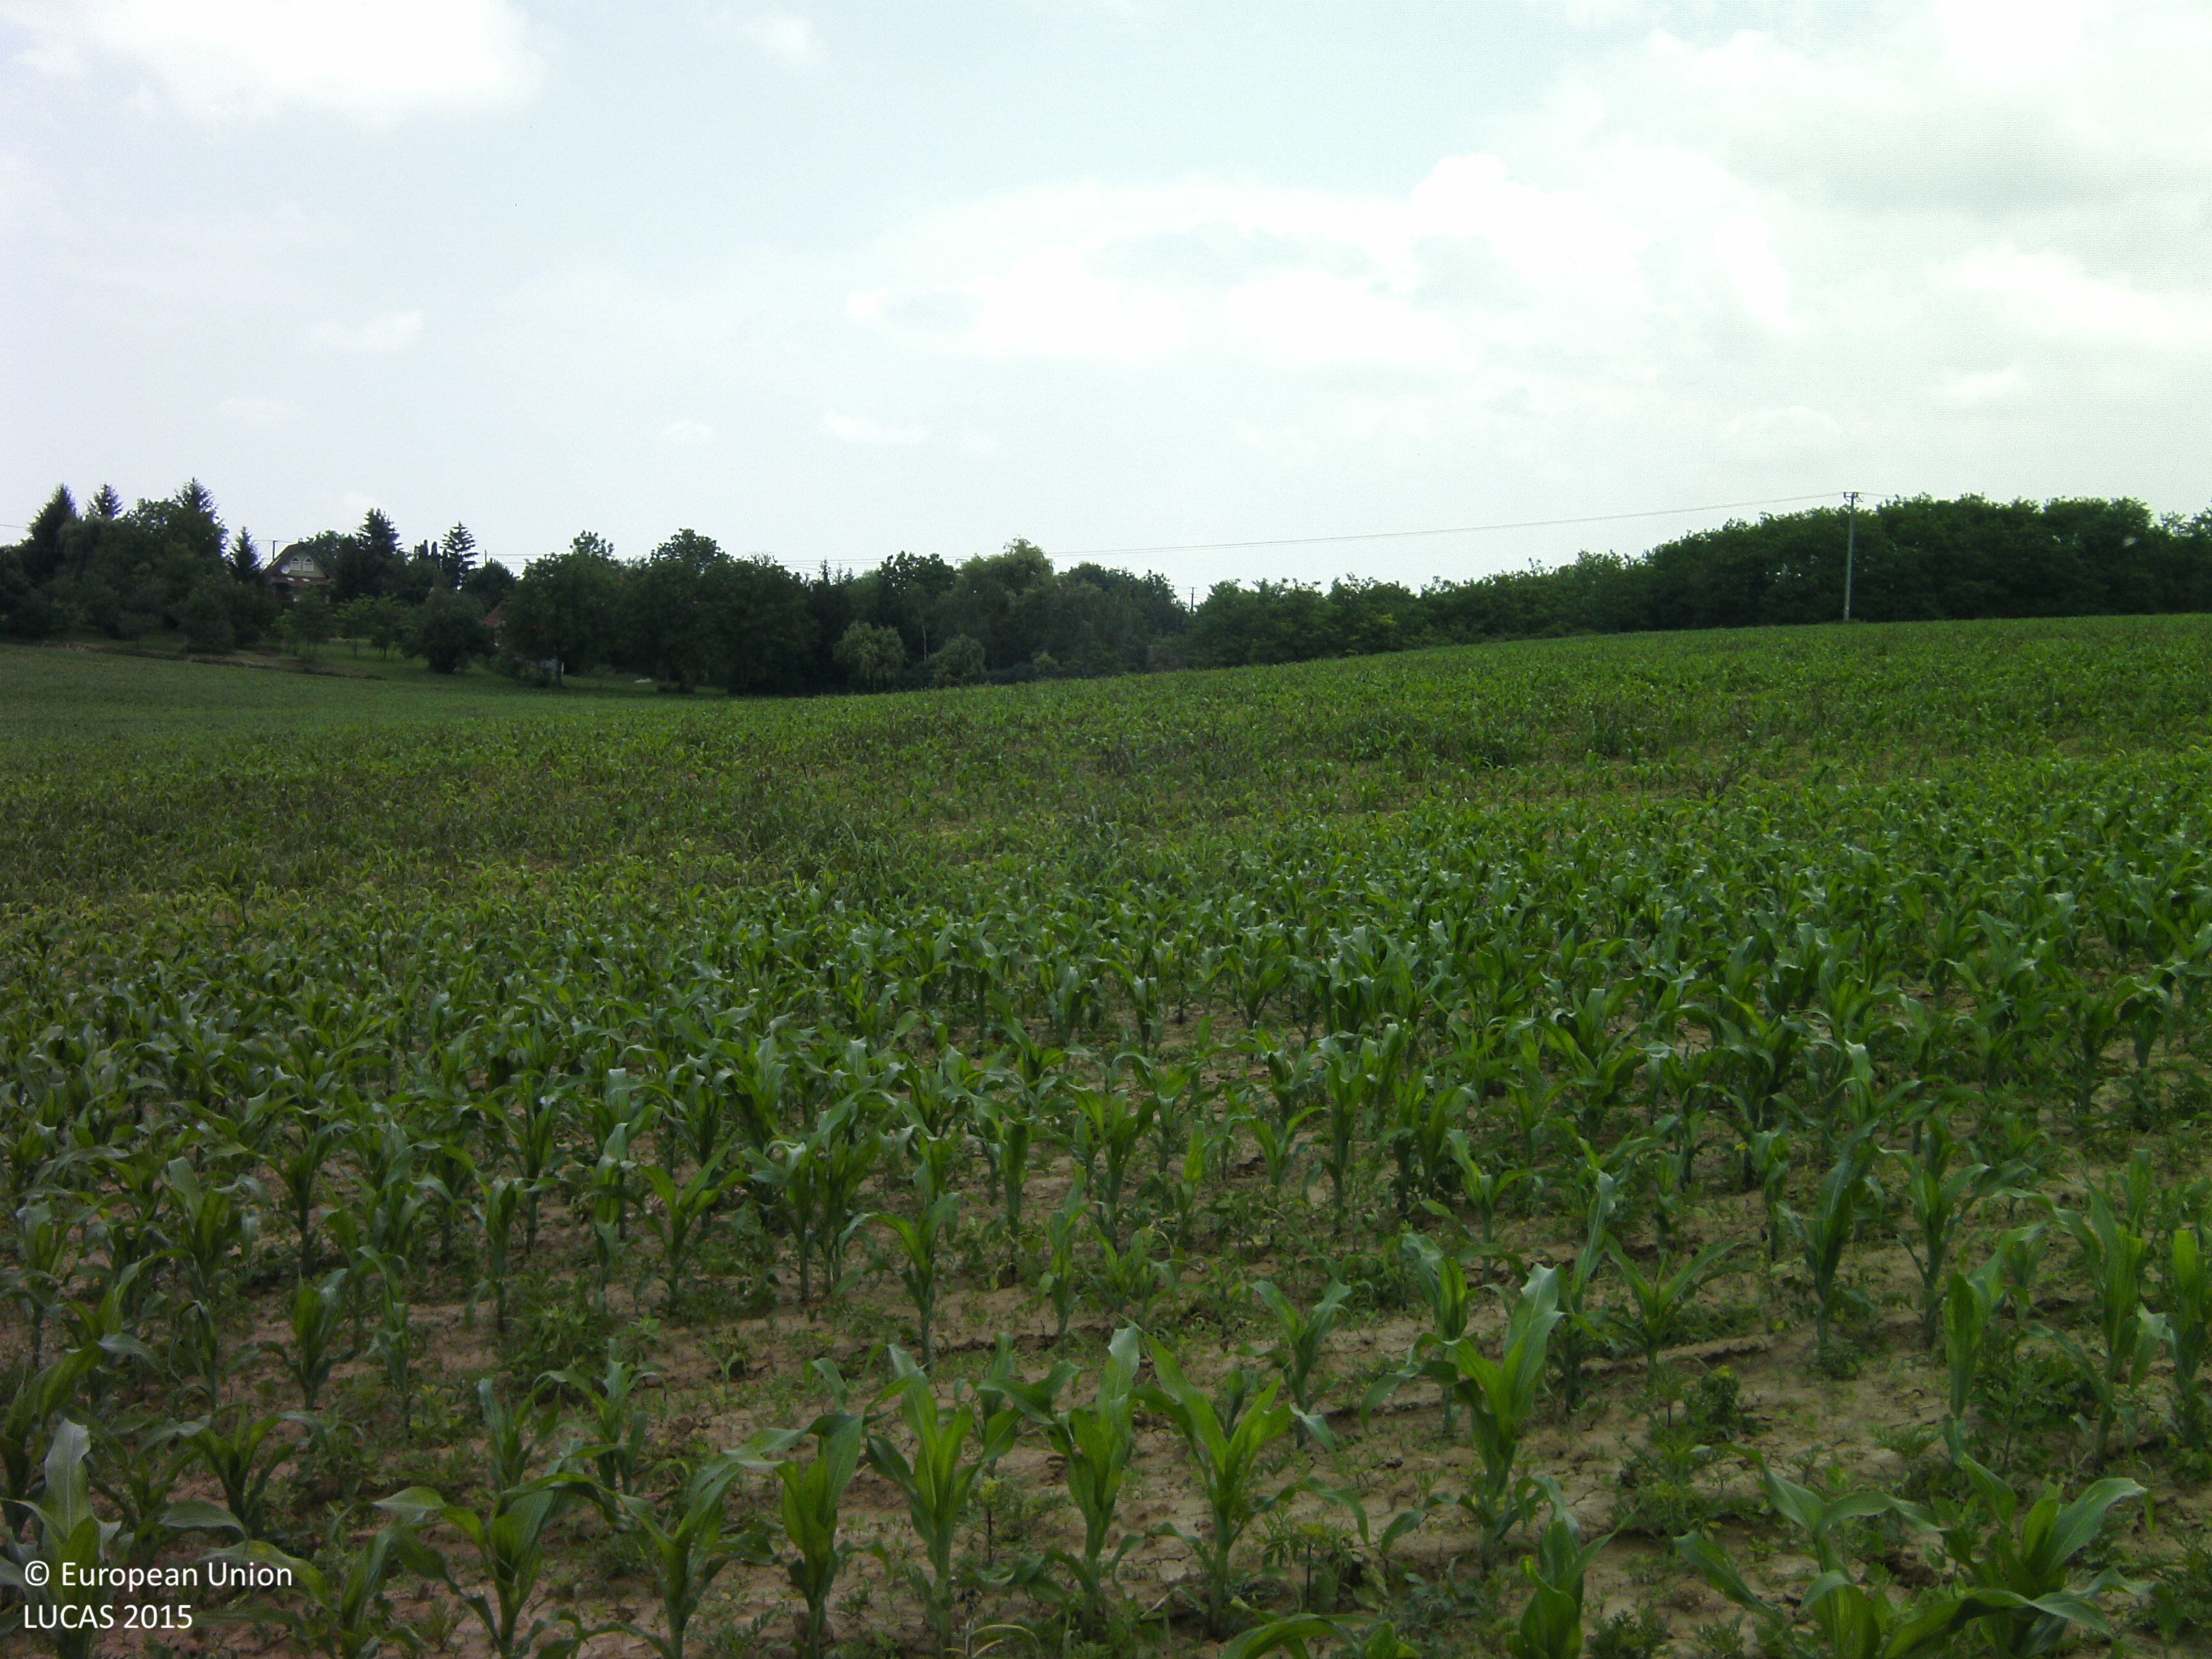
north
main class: Cropland
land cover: Maize
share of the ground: 25 - 50 %
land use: Agriculture (excluding fallow land and kitchen gardens)
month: June
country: HU
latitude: 46.4081
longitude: 17.8242
